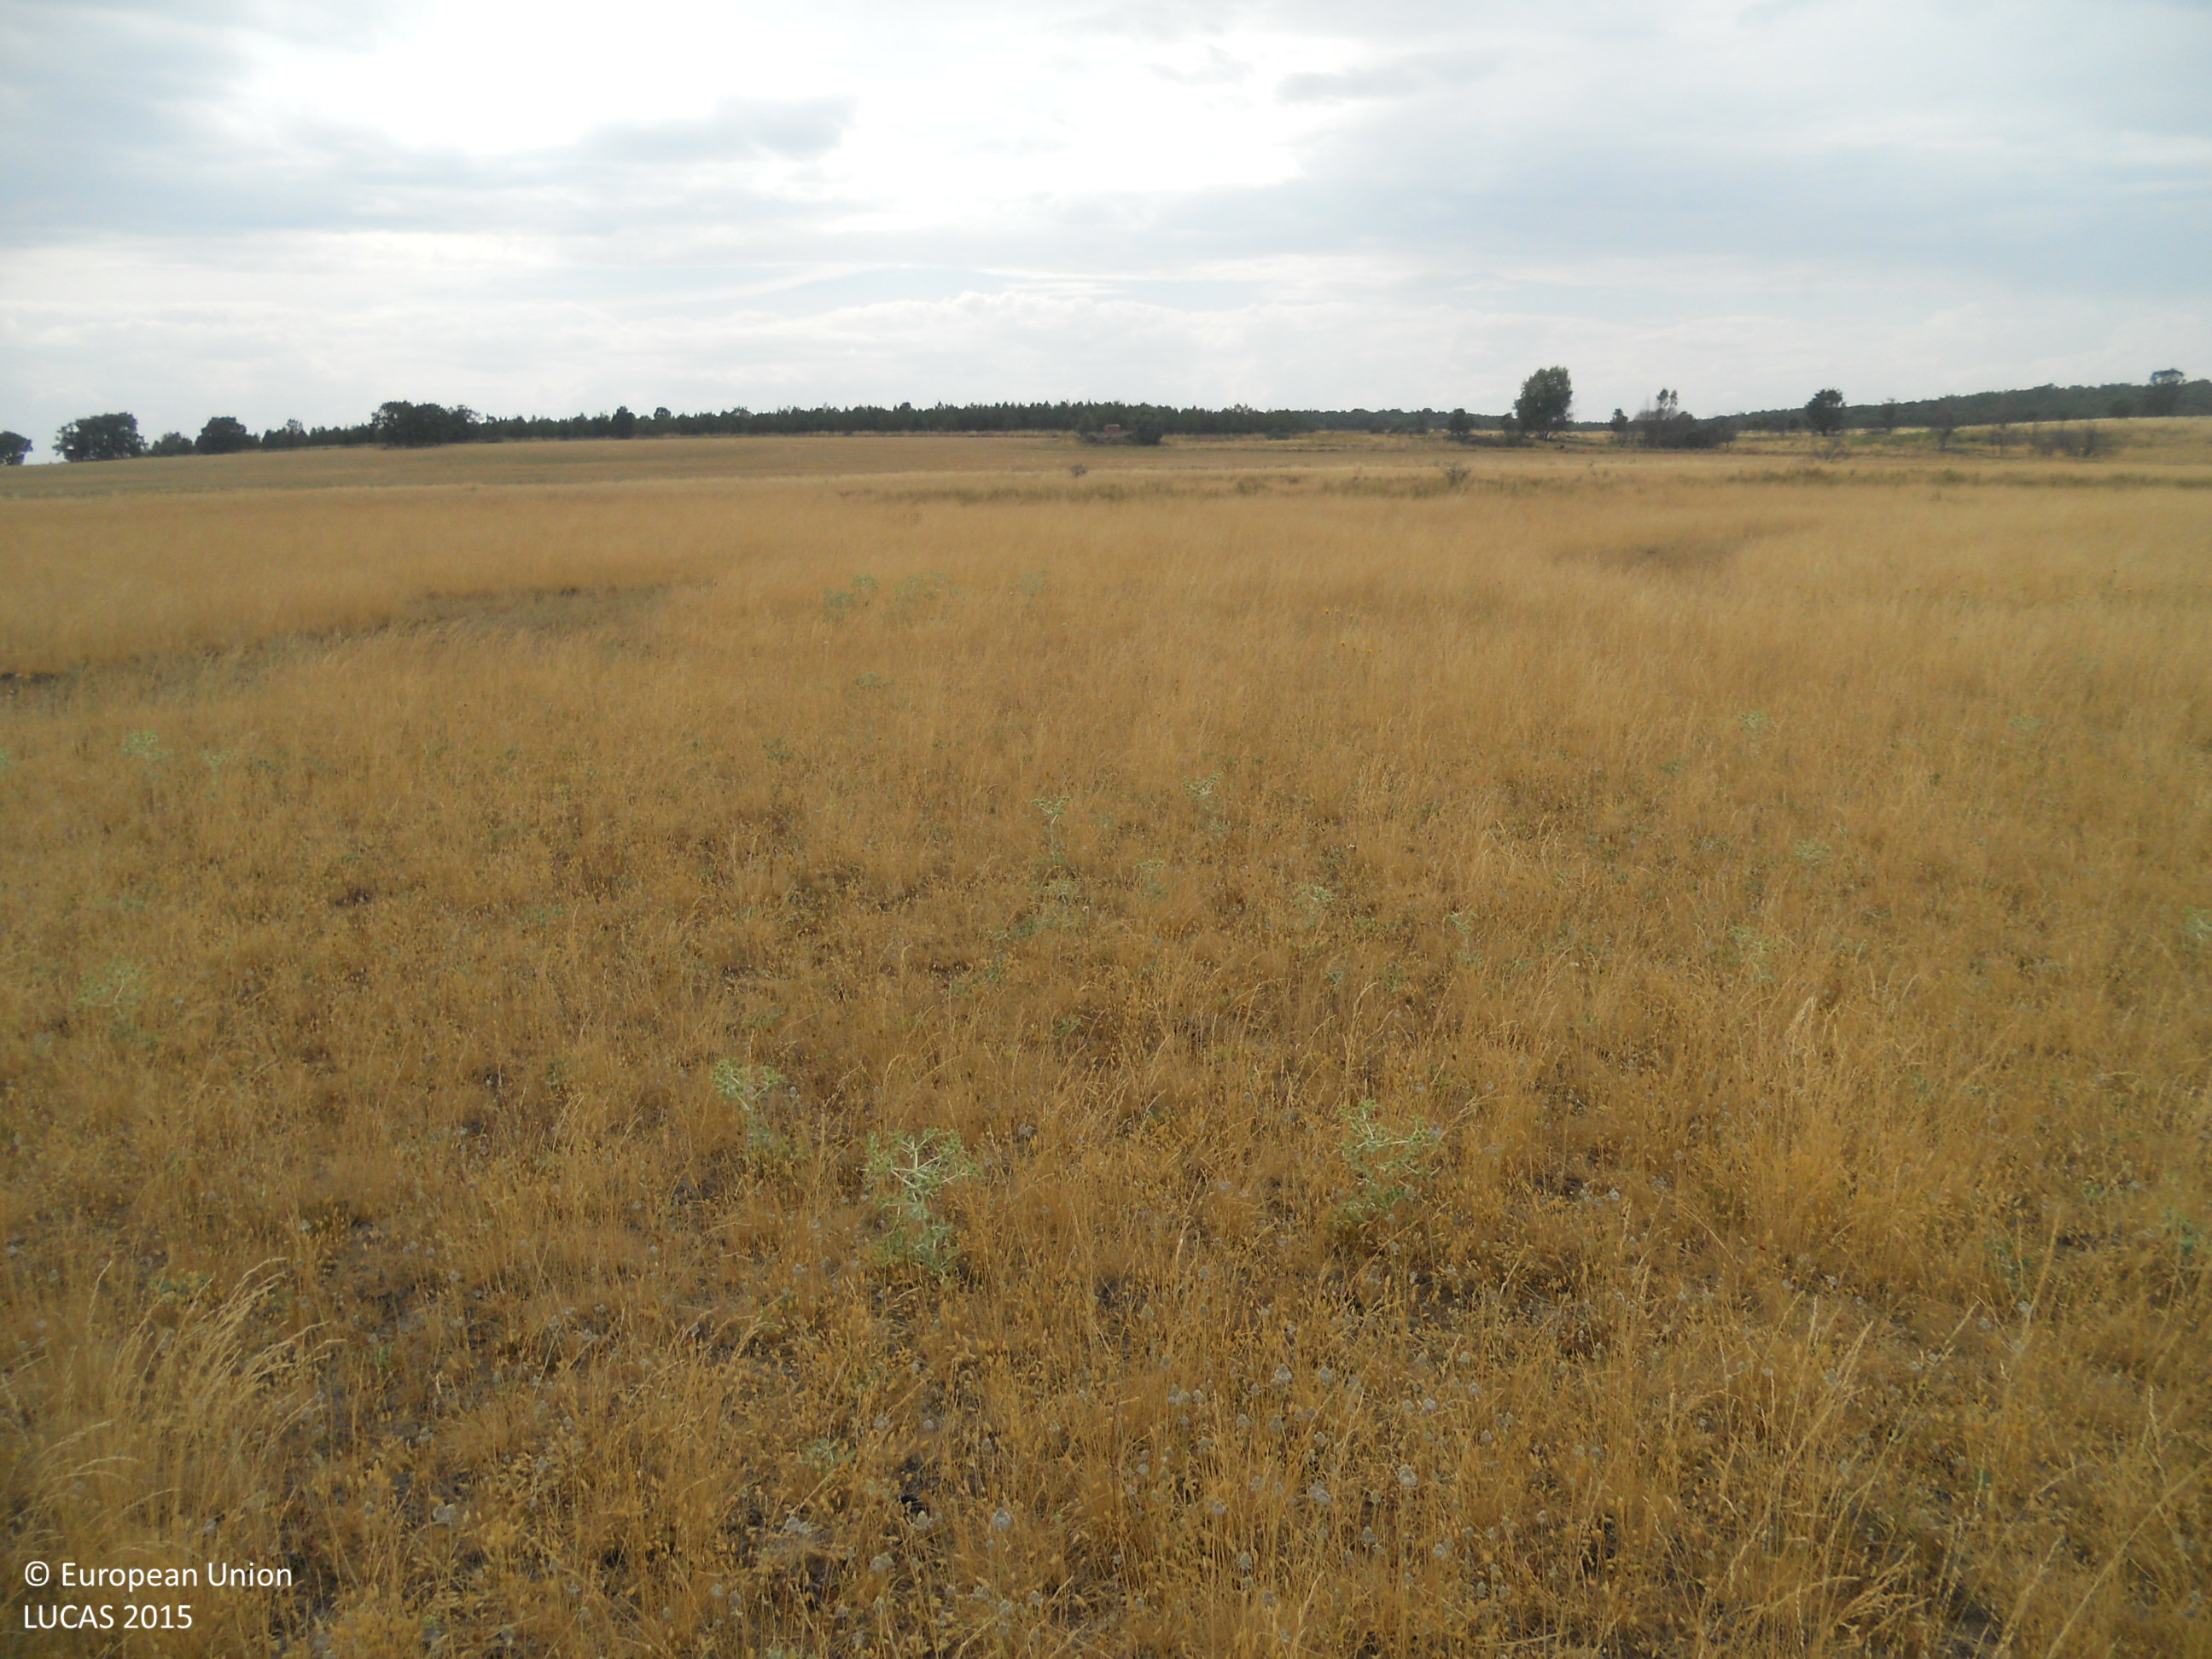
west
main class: Grassland
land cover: Spontaneously vegetated surfaces
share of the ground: > 75 %
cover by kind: herbaceous plants 100 %
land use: Fallow land
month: July
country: ES
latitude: 42.6211
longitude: -5.4197
